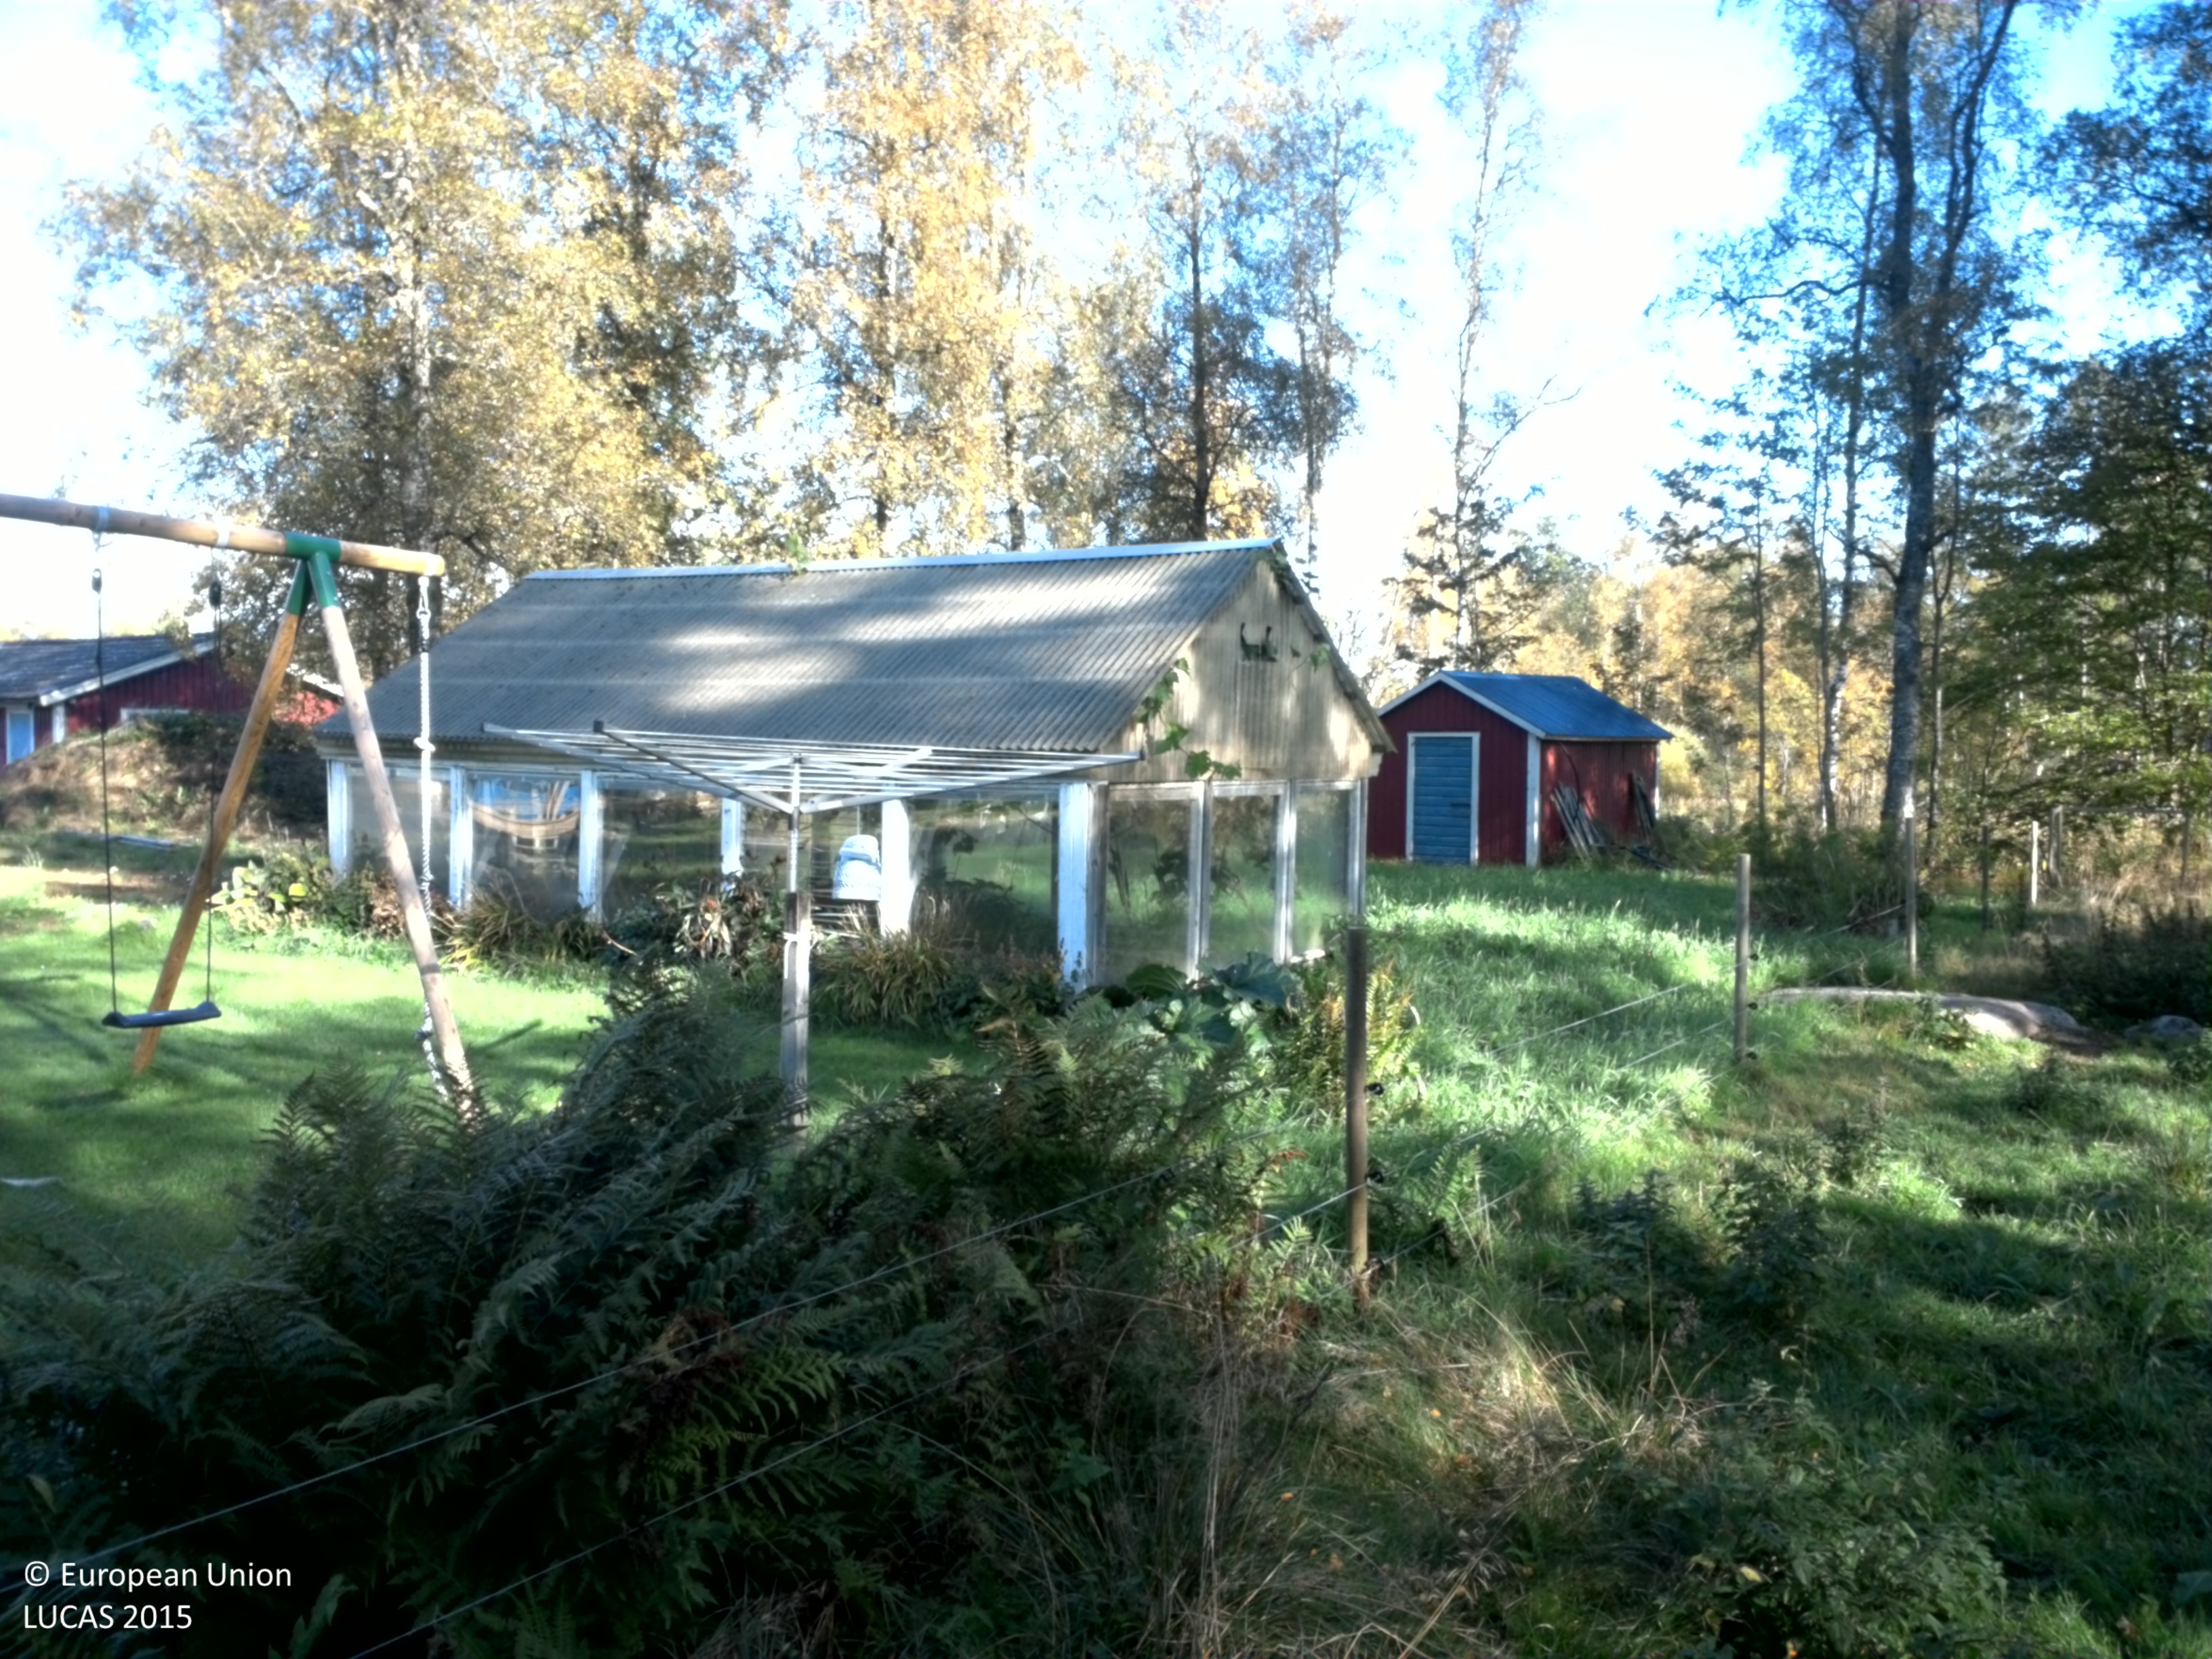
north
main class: Woodland
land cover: Broadleaved woodland
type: hemiboreal forest and nemoral coniferous forest and mixed broadleaved-coniferous forest
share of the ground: 10 - 25 %
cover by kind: herbaceous plants 80 %, broadleaved forest trees 15 %, shrubs 5 %
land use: Agriculture (excluding fallow land and kitchen gardens)
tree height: > 5 m
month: September
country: SE
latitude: 57.8930
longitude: 13.2171
